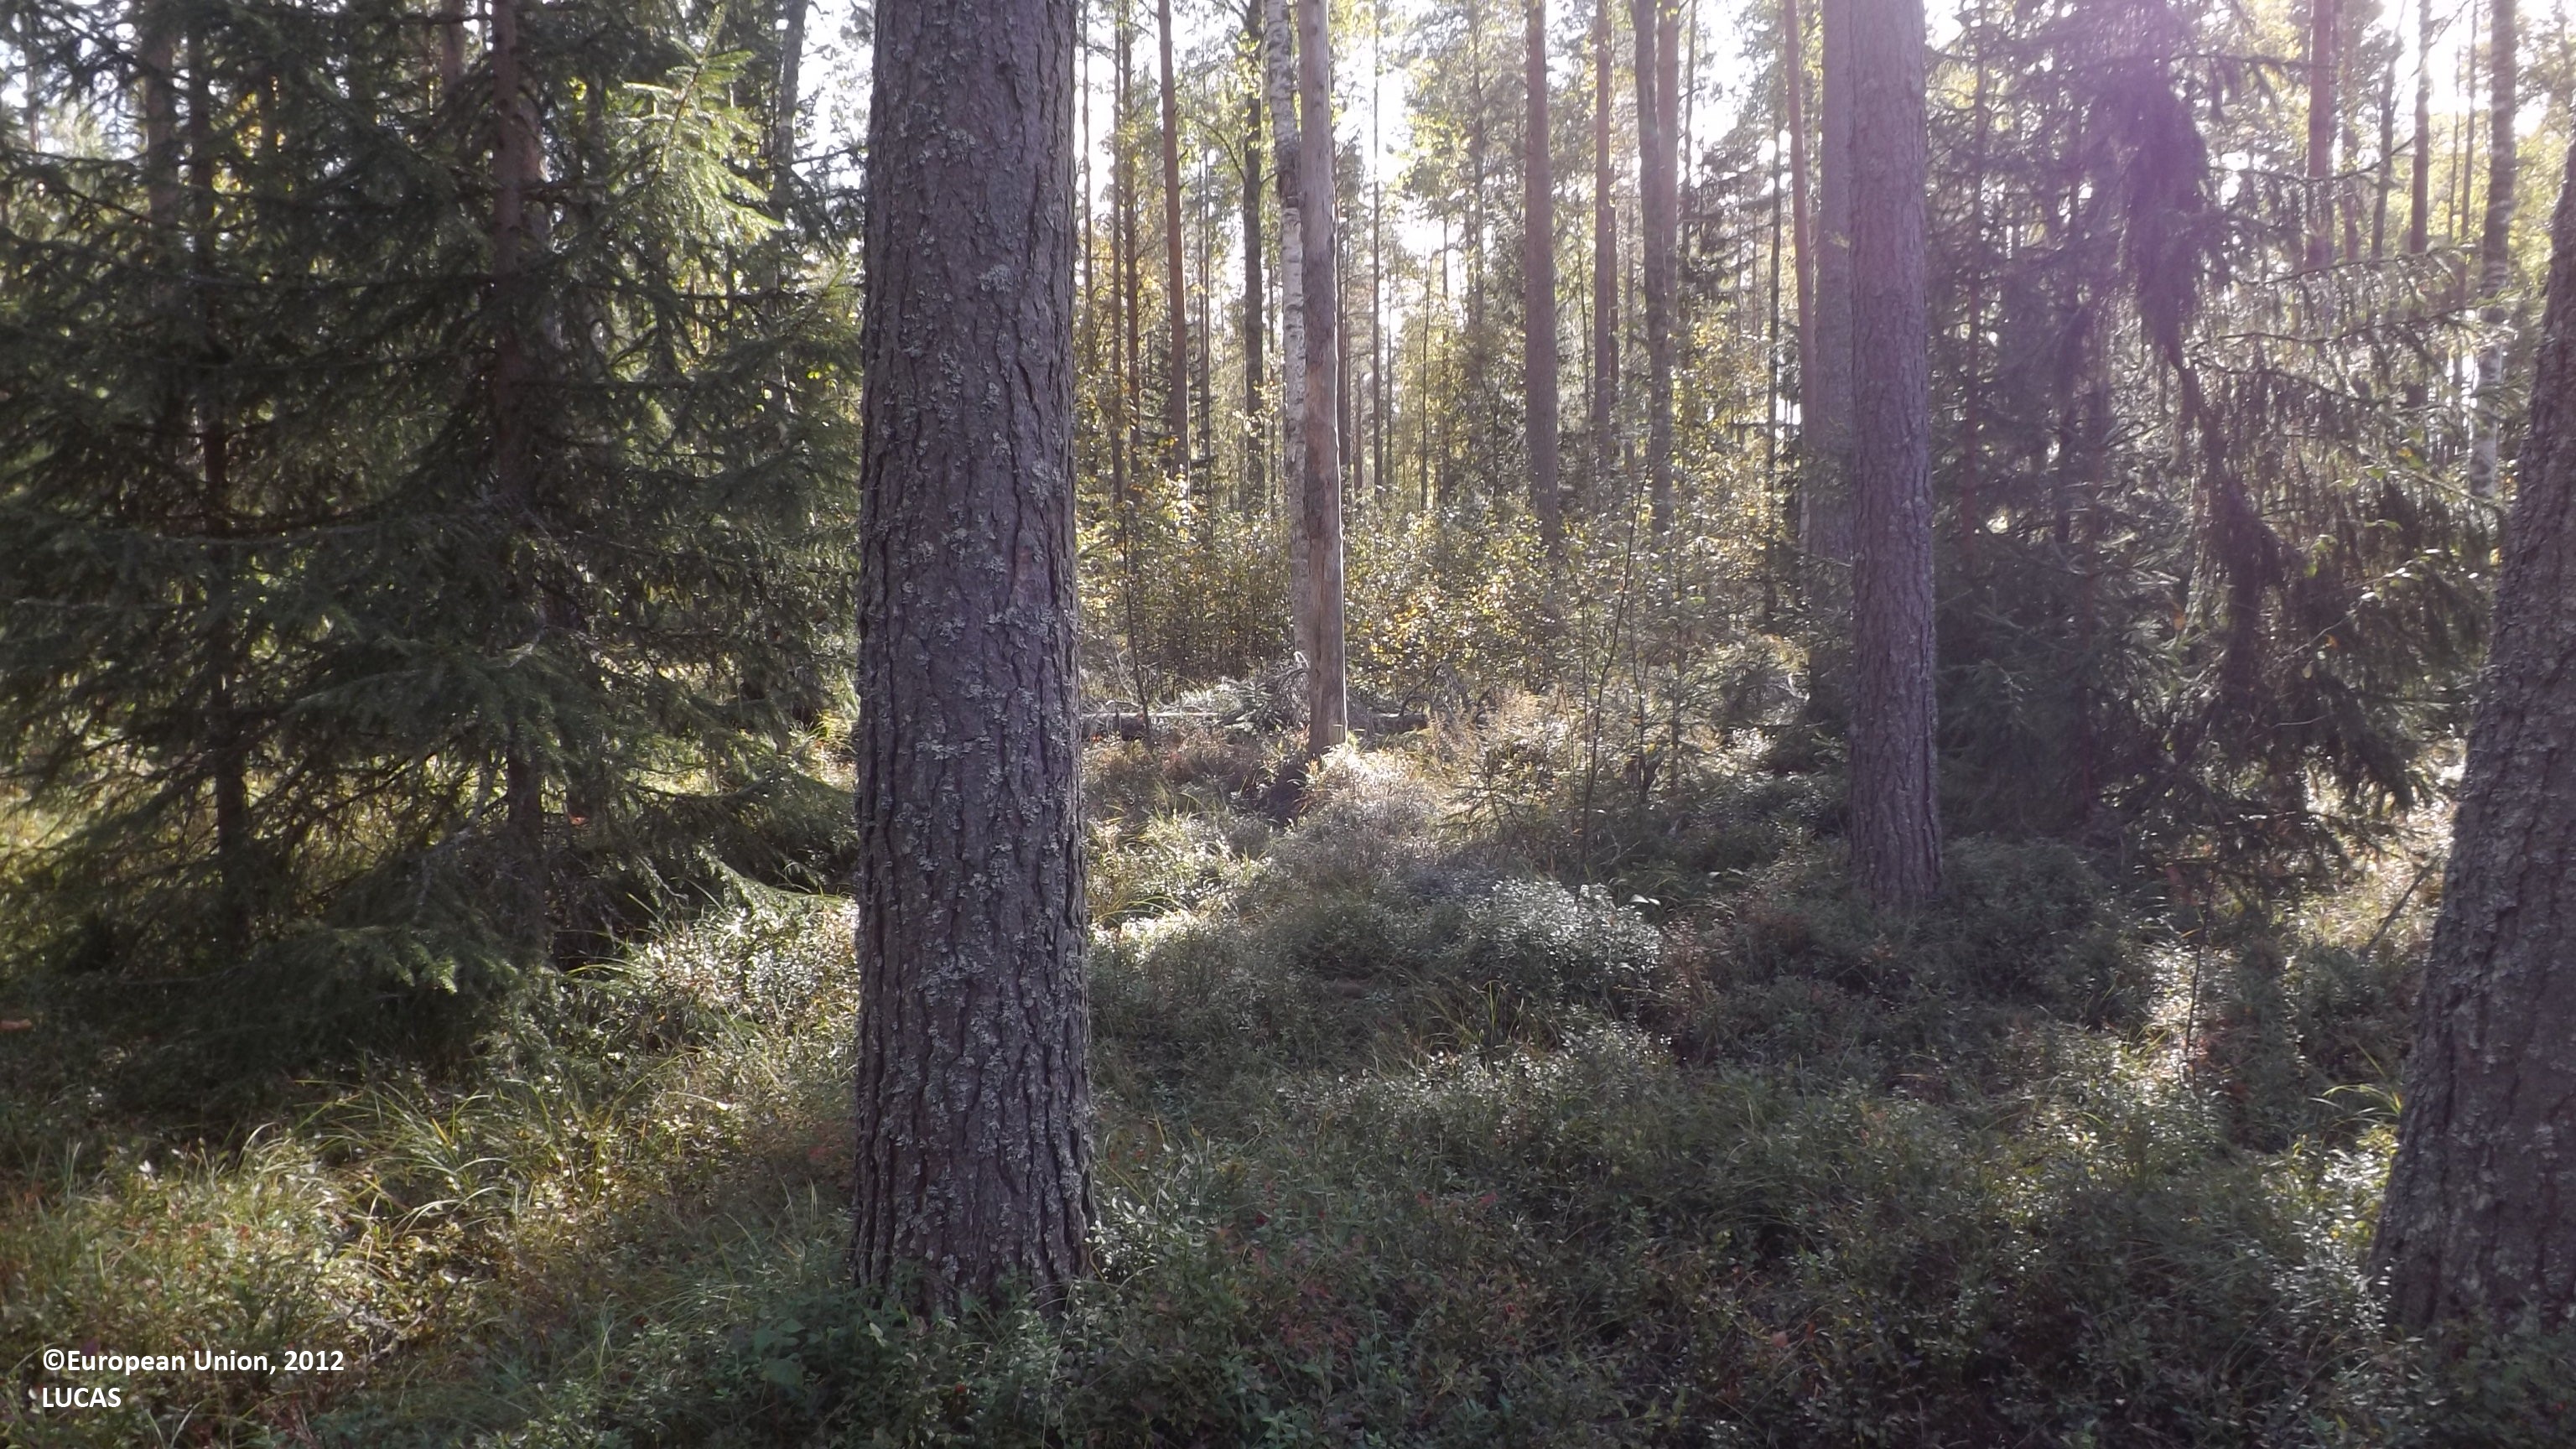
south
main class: Woodland
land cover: Pine dominated mixed woodland
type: boreal forest
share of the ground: 50 - 75 %
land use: Forestry
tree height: > 5 m
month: August
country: FI
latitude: 63.9076
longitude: 23.7358
